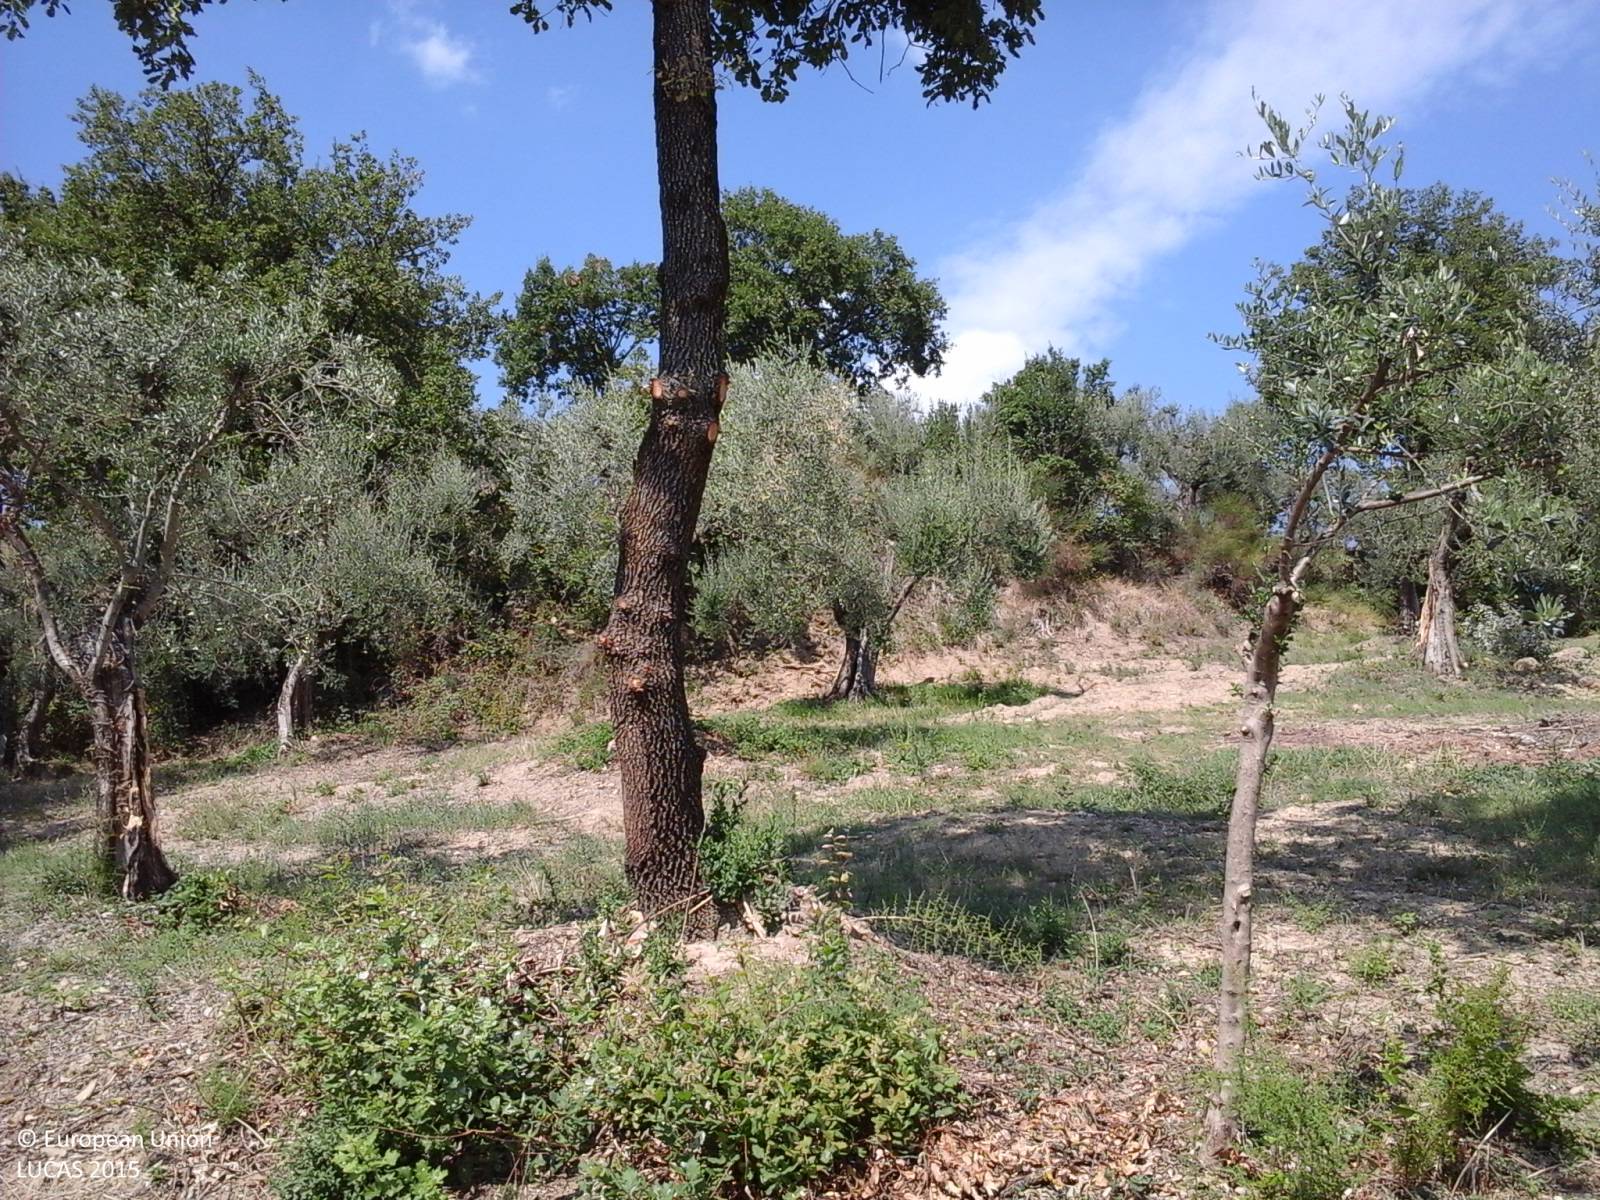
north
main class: Cropland
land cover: Olive groves
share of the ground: 25 - 50 %
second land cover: Grassland without tree/shrub cover
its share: > 75 %
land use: Agriculture (excluding fallow land and kitchen gardens)
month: September
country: IT
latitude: 43.1164
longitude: 12.2670
